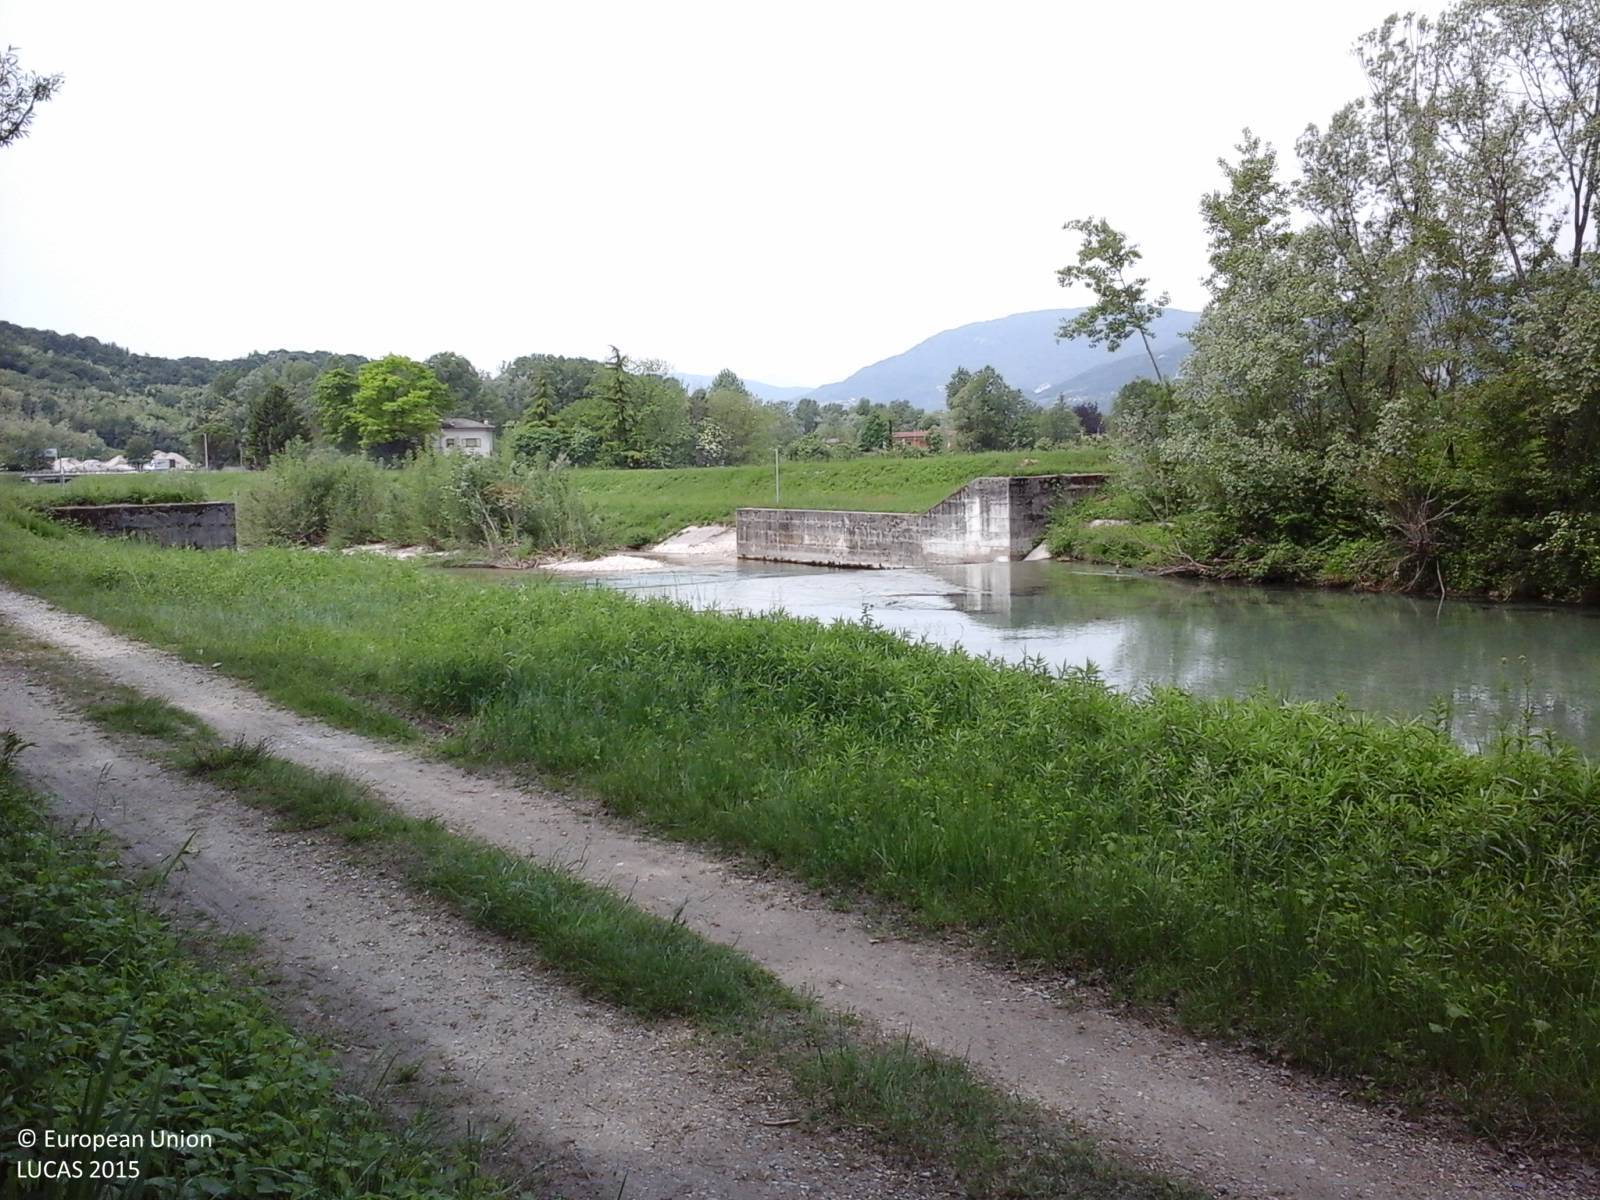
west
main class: Woodland
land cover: Broadleaved woodland
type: floodplain forest
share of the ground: > 75 %
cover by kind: broadleaved forest trees 80 %, shrubs 20 %
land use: Forestry
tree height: > 5 m
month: May
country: IT
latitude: 46.1991
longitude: 13.0679
